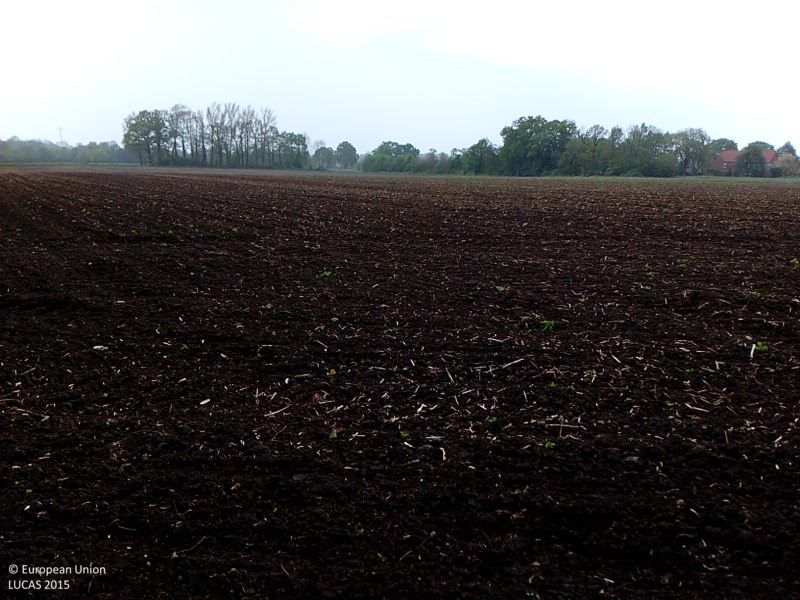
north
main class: Cropland
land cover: Maize
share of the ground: < 10 %
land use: Agriculture (excluding fallow land and kitchen gardens)
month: May
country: DE
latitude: 52.0623
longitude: 7.4477
